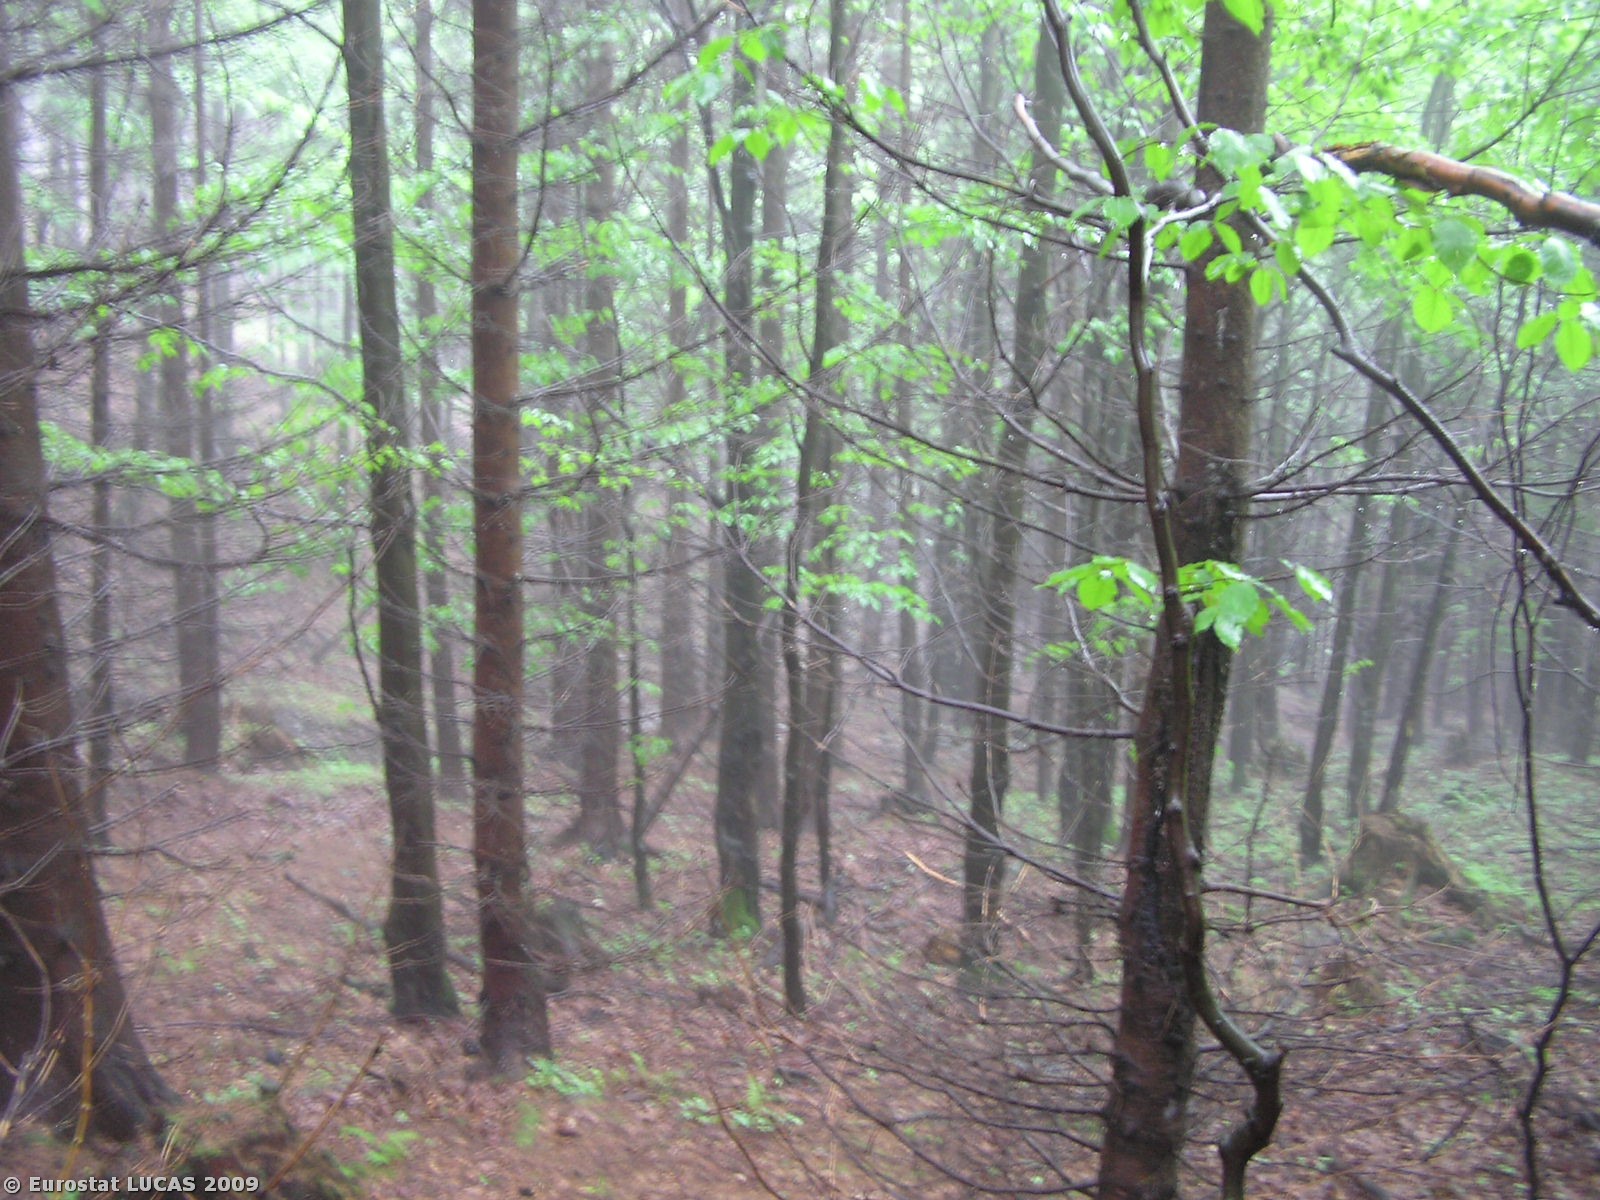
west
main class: Woodland
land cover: Mixed woodland
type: hemiboreal forest and nemoral coniferous forest and mixed broadleaved-coniferous forest
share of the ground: > 75 %
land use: Forestry
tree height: > 5 m
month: June
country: CZ
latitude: 50.1164
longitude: 17.2413
